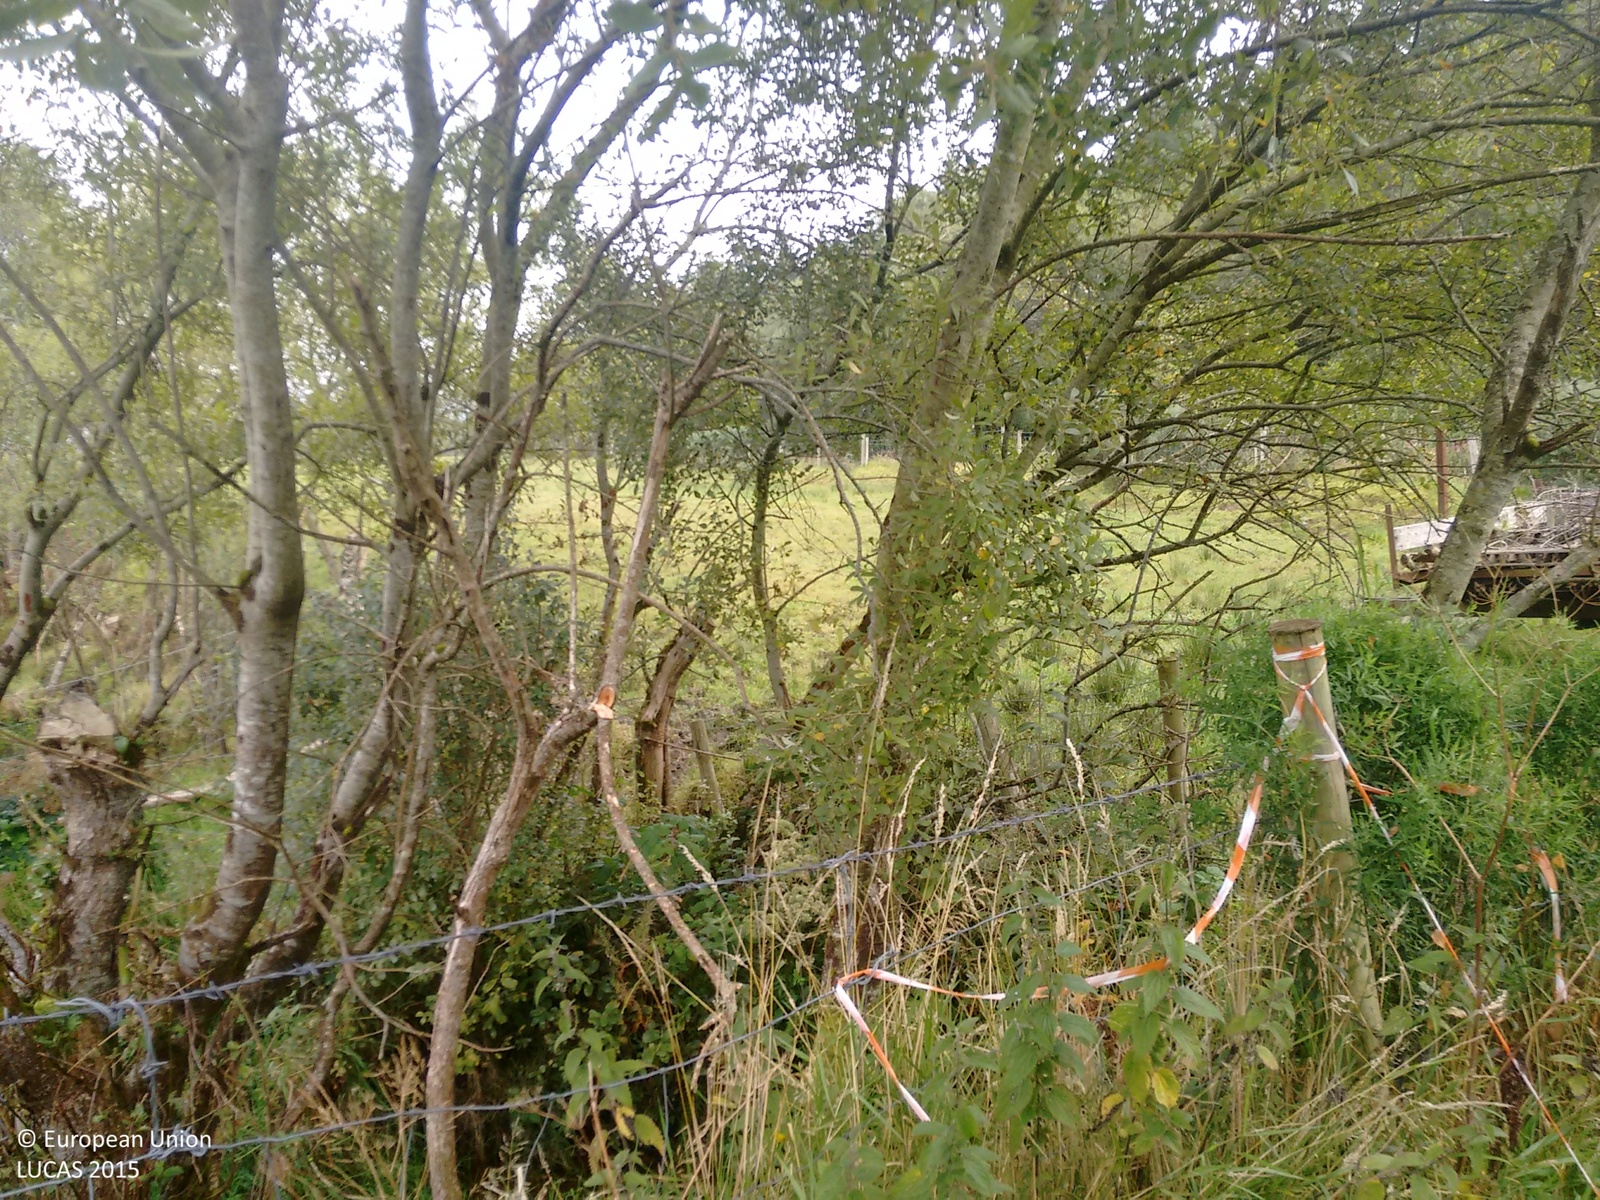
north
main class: Grassland
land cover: Grassland without tree/shrub cover
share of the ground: > 75 %
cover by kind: herbaceous plants 100 %
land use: Agriculture (excluding fallow land and kitchen gardens)
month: September
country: IE
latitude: 55.0729
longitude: -7.2964
